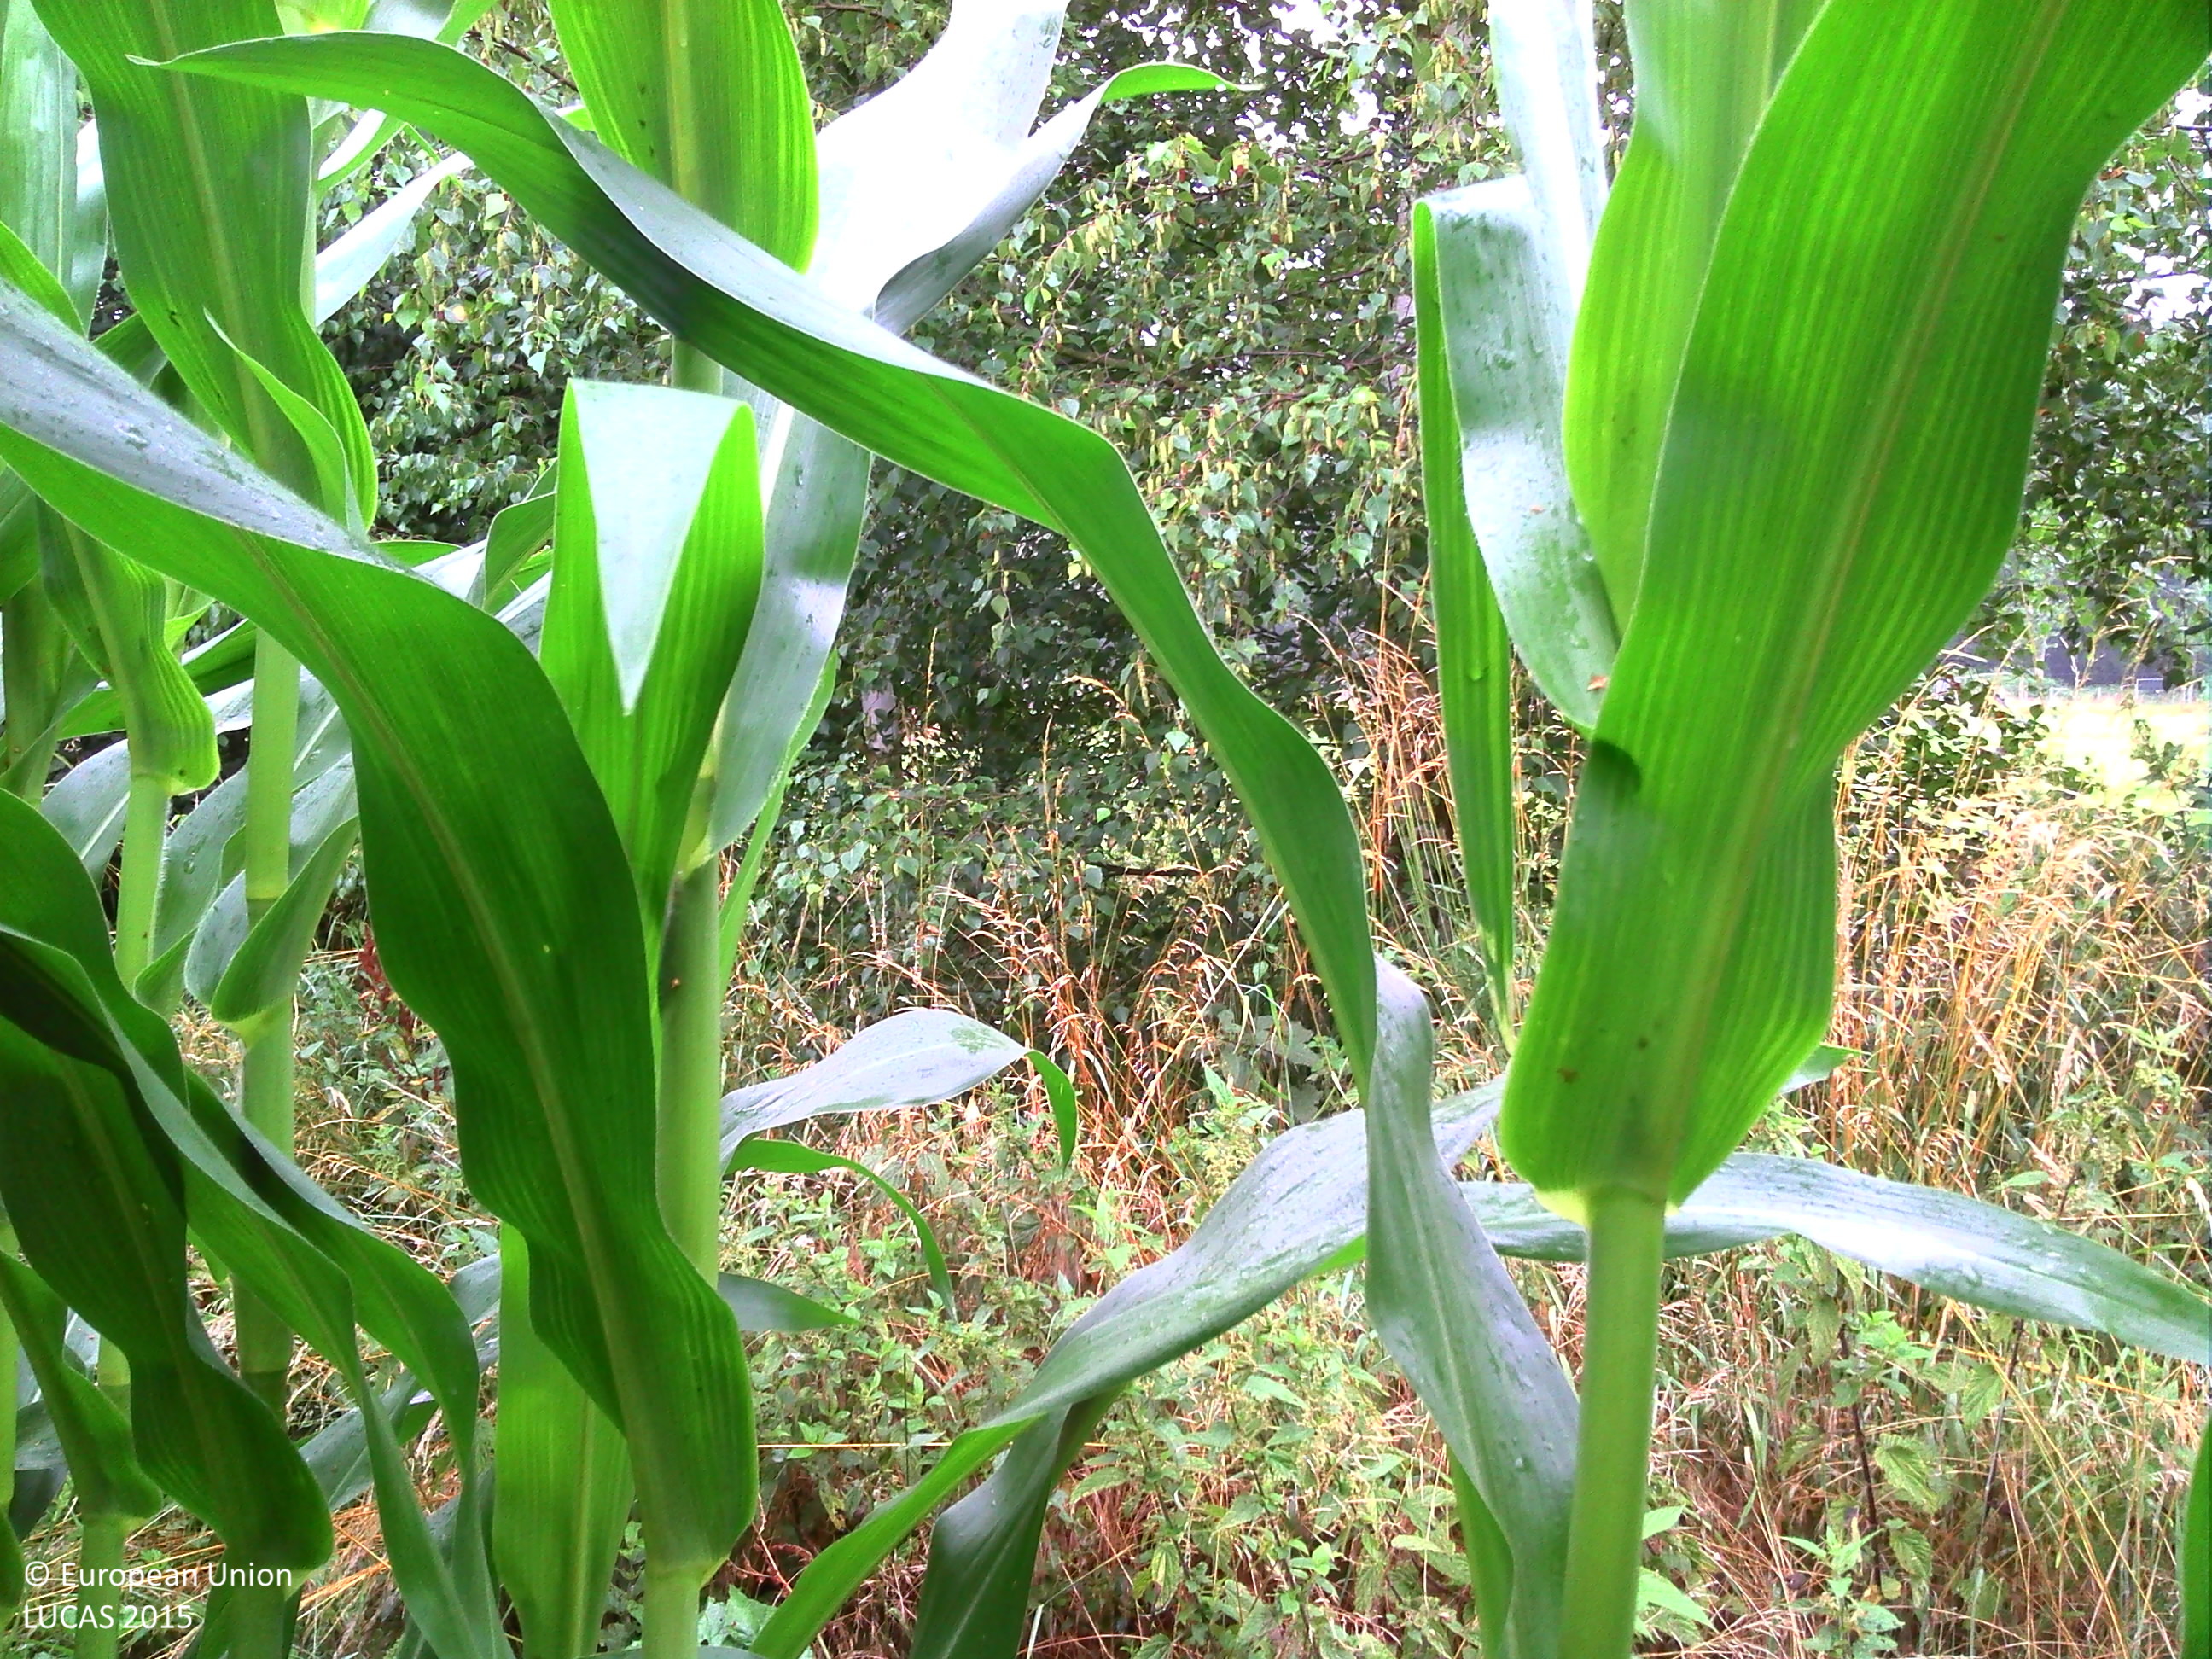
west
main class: Cropland
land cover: Maize
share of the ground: > 75 %
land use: Agriculture (excluding fallow land and kitchen gardens)
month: July
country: BE
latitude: 50.9044
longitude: 5.4618
